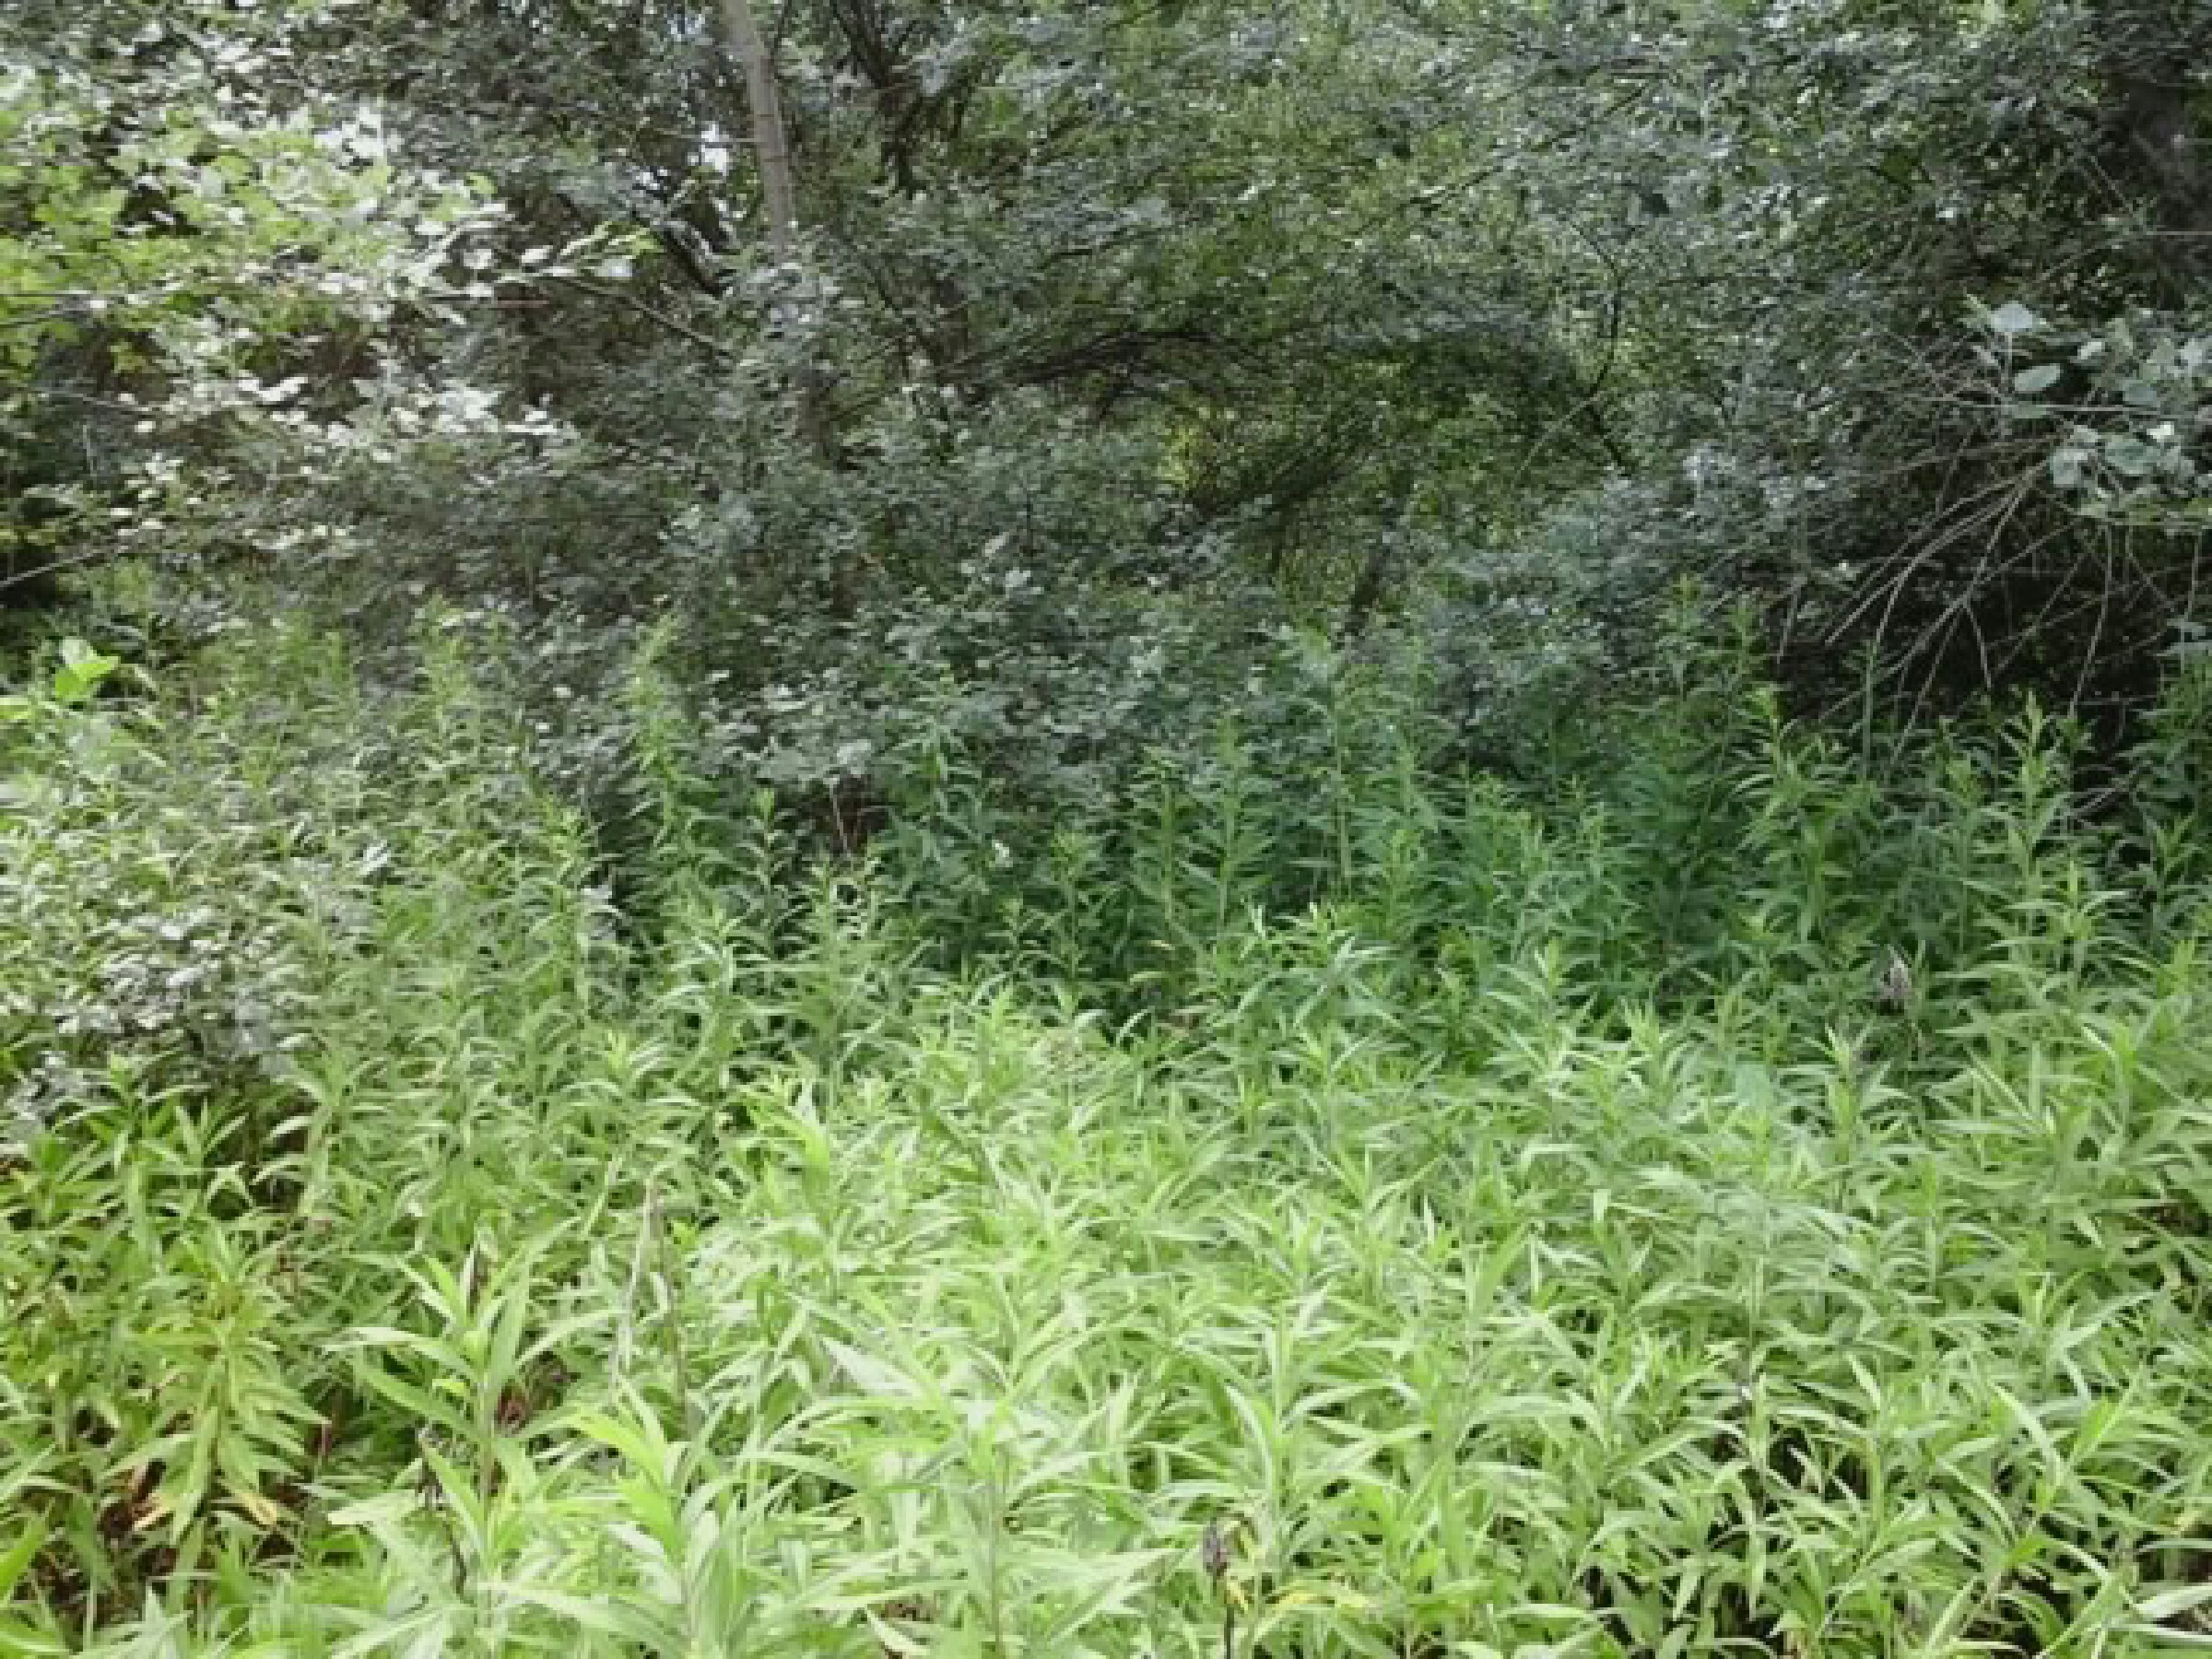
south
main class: Grassland
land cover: Spontaneously vegetated surfaces
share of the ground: > 75 %
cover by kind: herbaceous plants 100 %
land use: Semi-natural and natural areas not in use
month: July
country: HU
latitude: 47.7512
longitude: 19.1566
